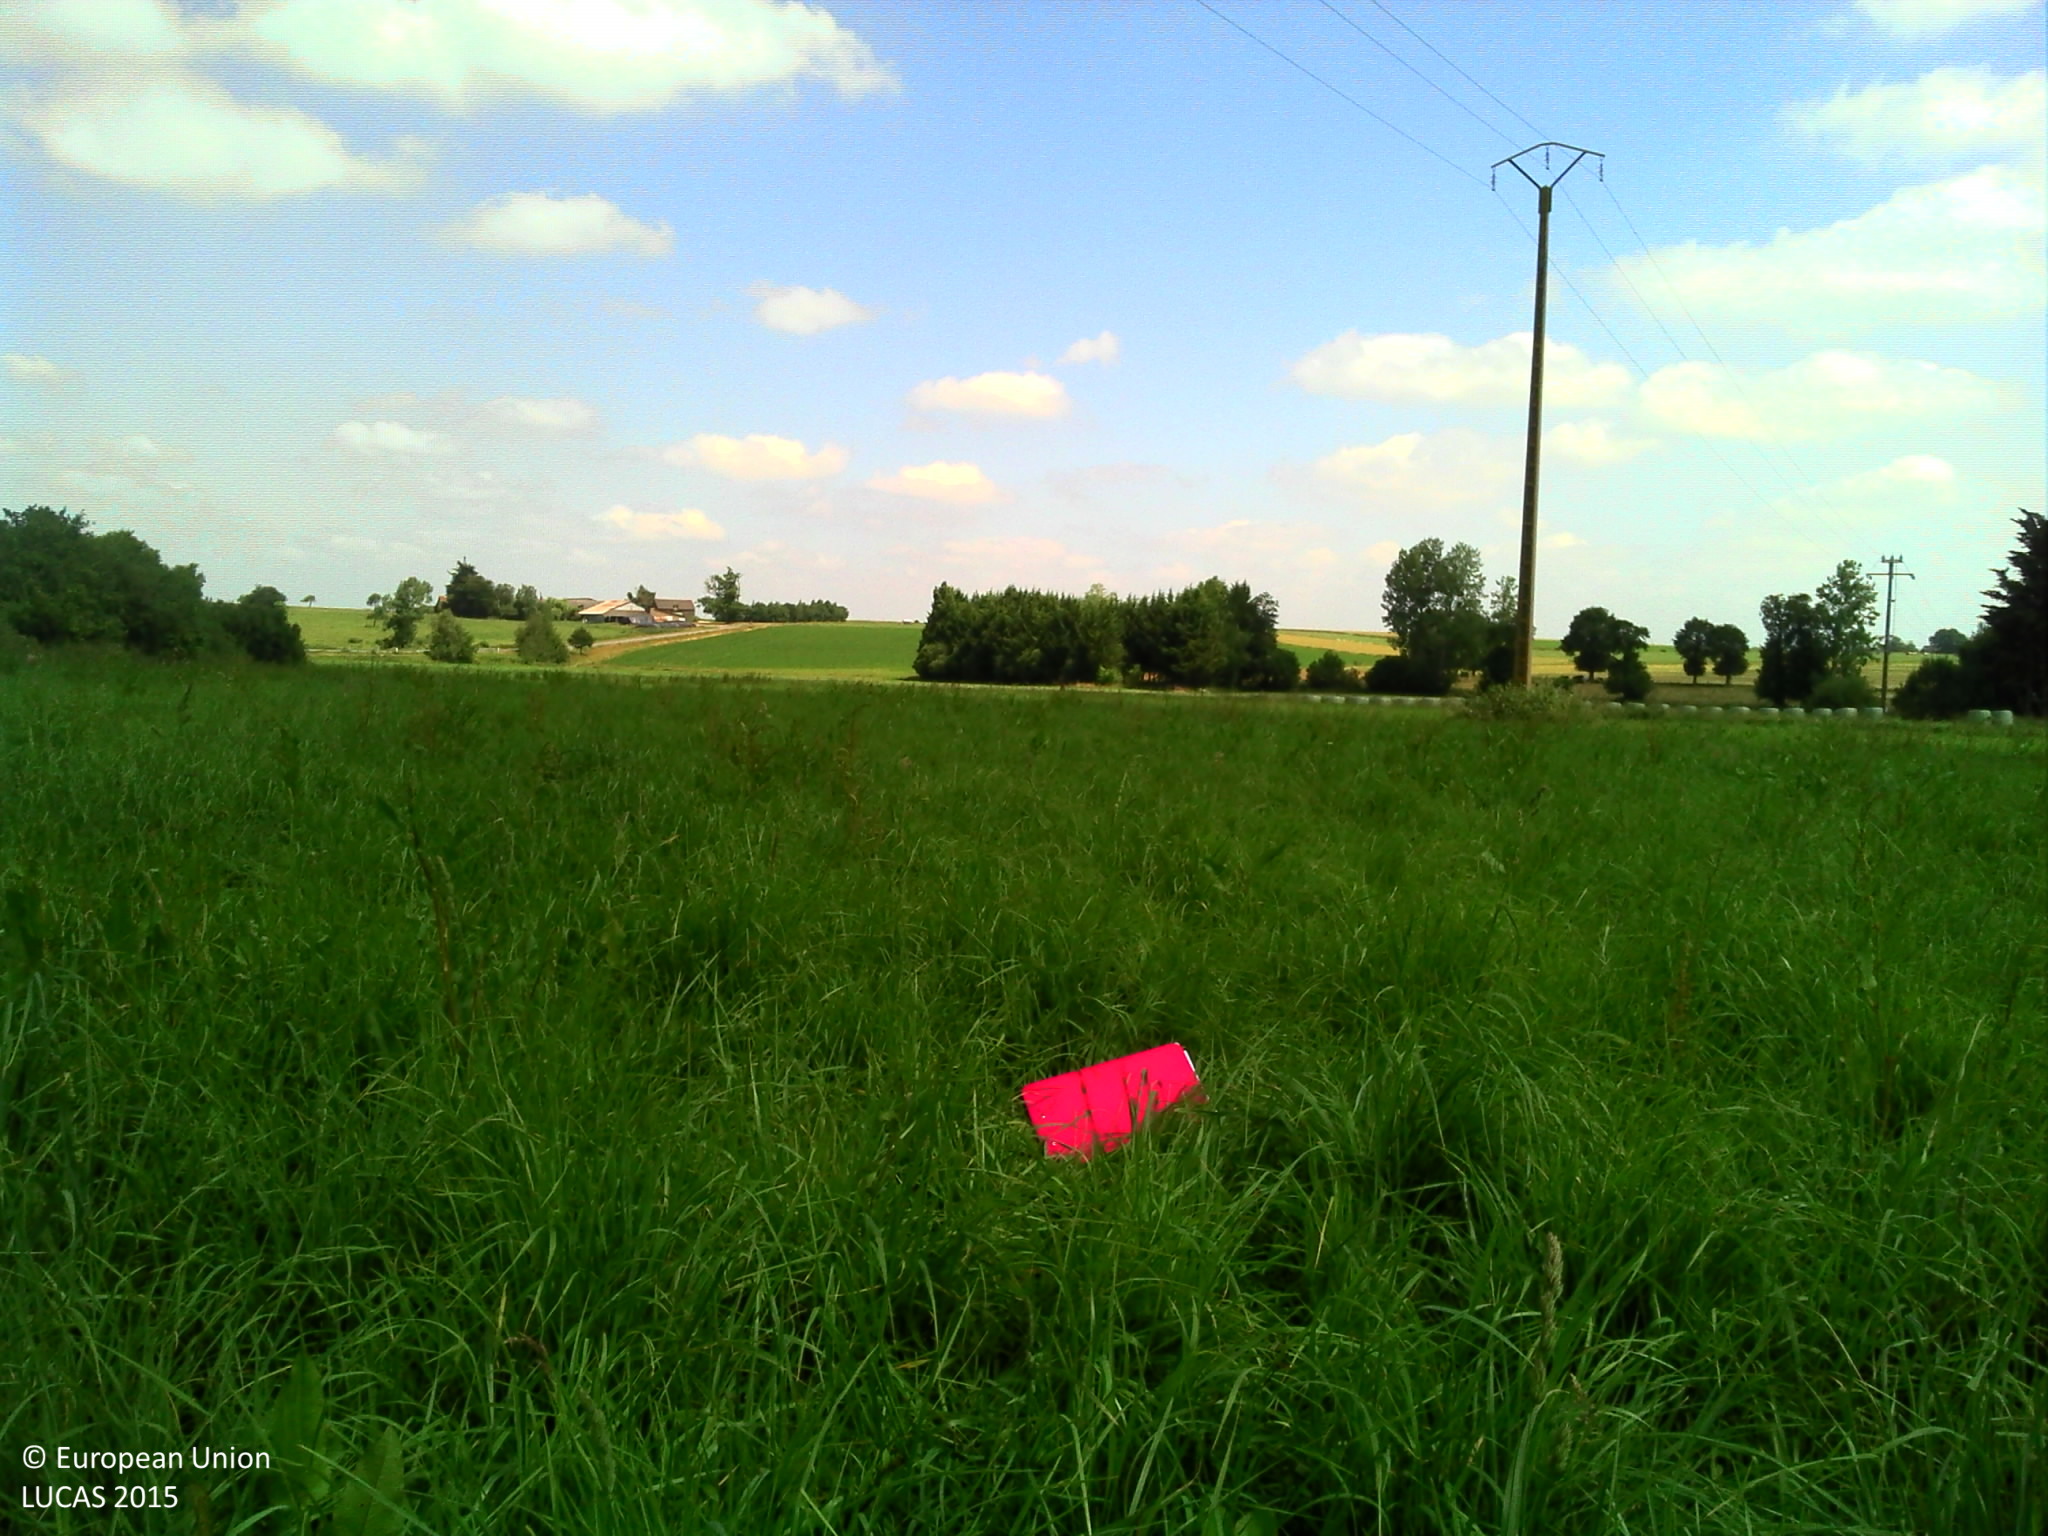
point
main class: Grassland
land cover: Grassland without tree/shrub cover
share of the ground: > 75 %
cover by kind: herbaceous plants 100 %
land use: Agriculture (excluding fallow land and kitchen gardens)
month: June
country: FR
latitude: 48.0318
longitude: -1.8924
